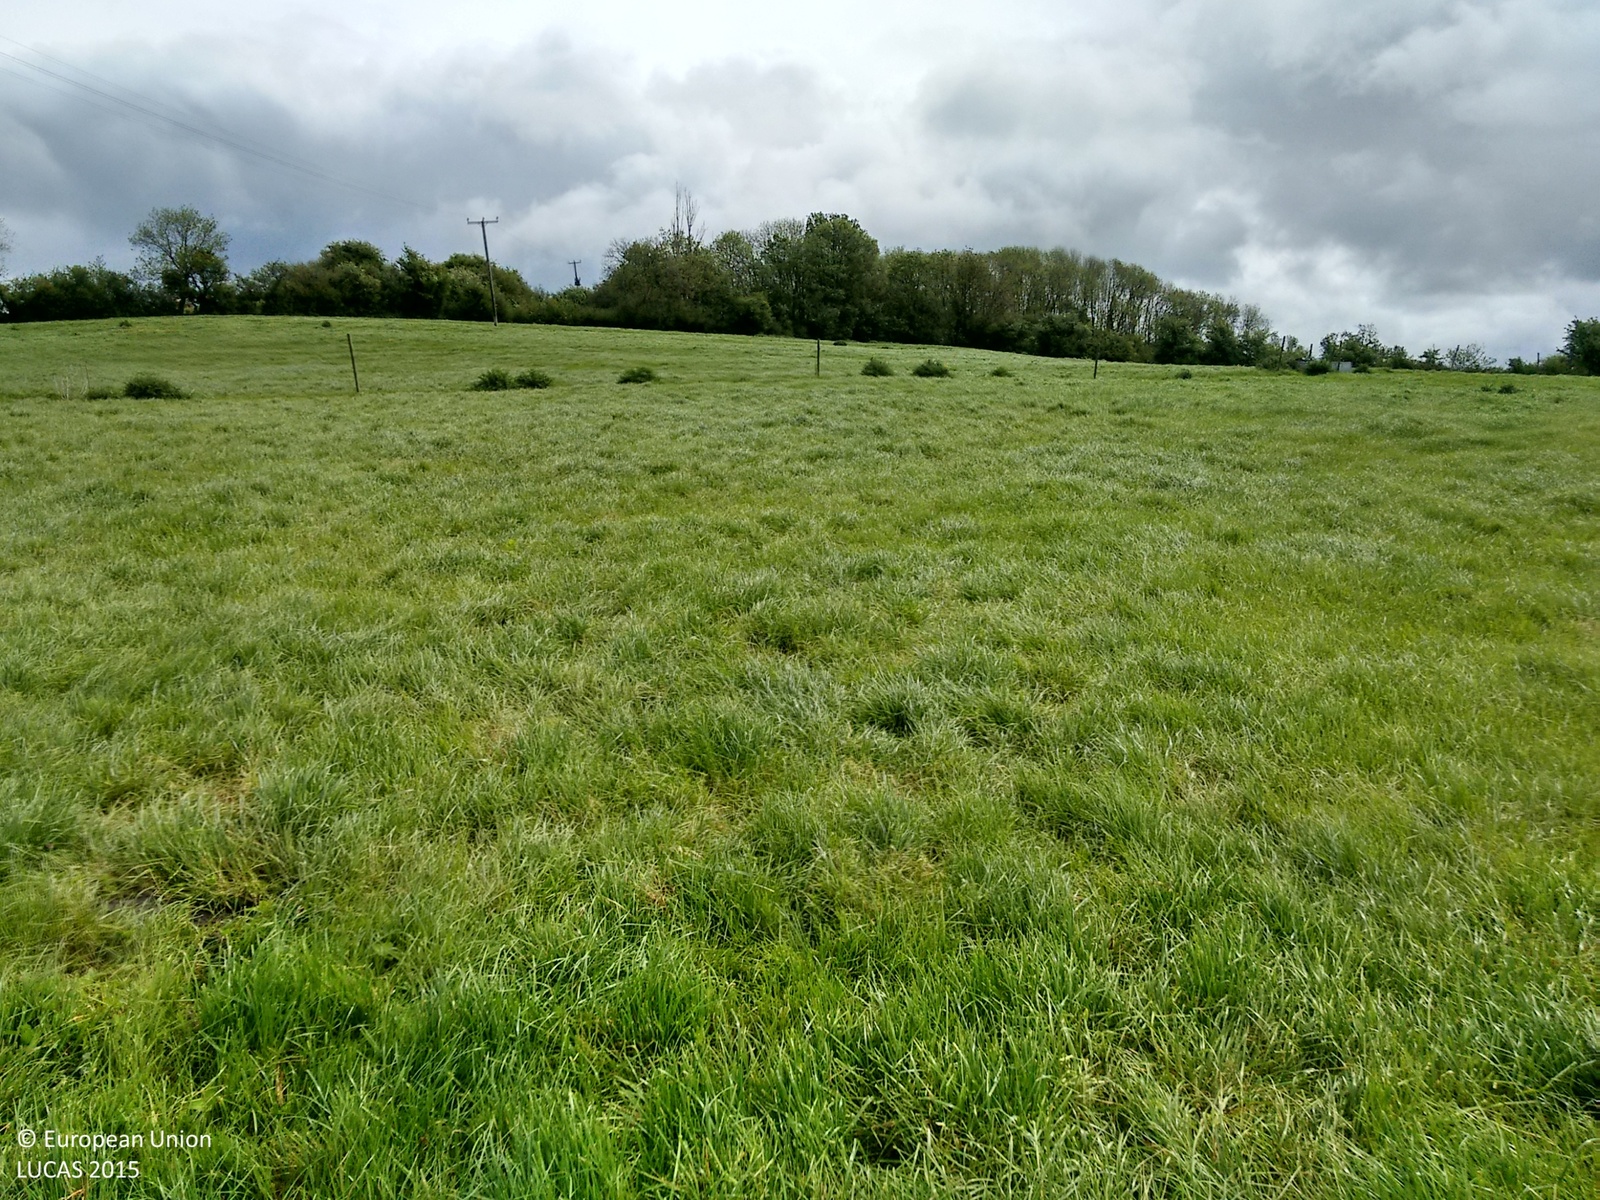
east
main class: Grassland
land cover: Grassland without tree/shrub cover
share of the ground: > 75 %
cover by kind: herbaceous plants 100 %
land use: Agriculture (excluding fallow land and kitchen gardens)
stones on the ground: < 10 %
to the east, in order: Grassland without tree/shrub cover; Fences; Grassland without tree/shrub cover; Broadleaved woodland; Grassland without tree/shrub cover; Managed hedges; Grassland without tree/shrub cover; Electric lines; Grassland without tree/shrub cover
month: May
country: GB
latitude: 51.0035
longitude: -2.3335
